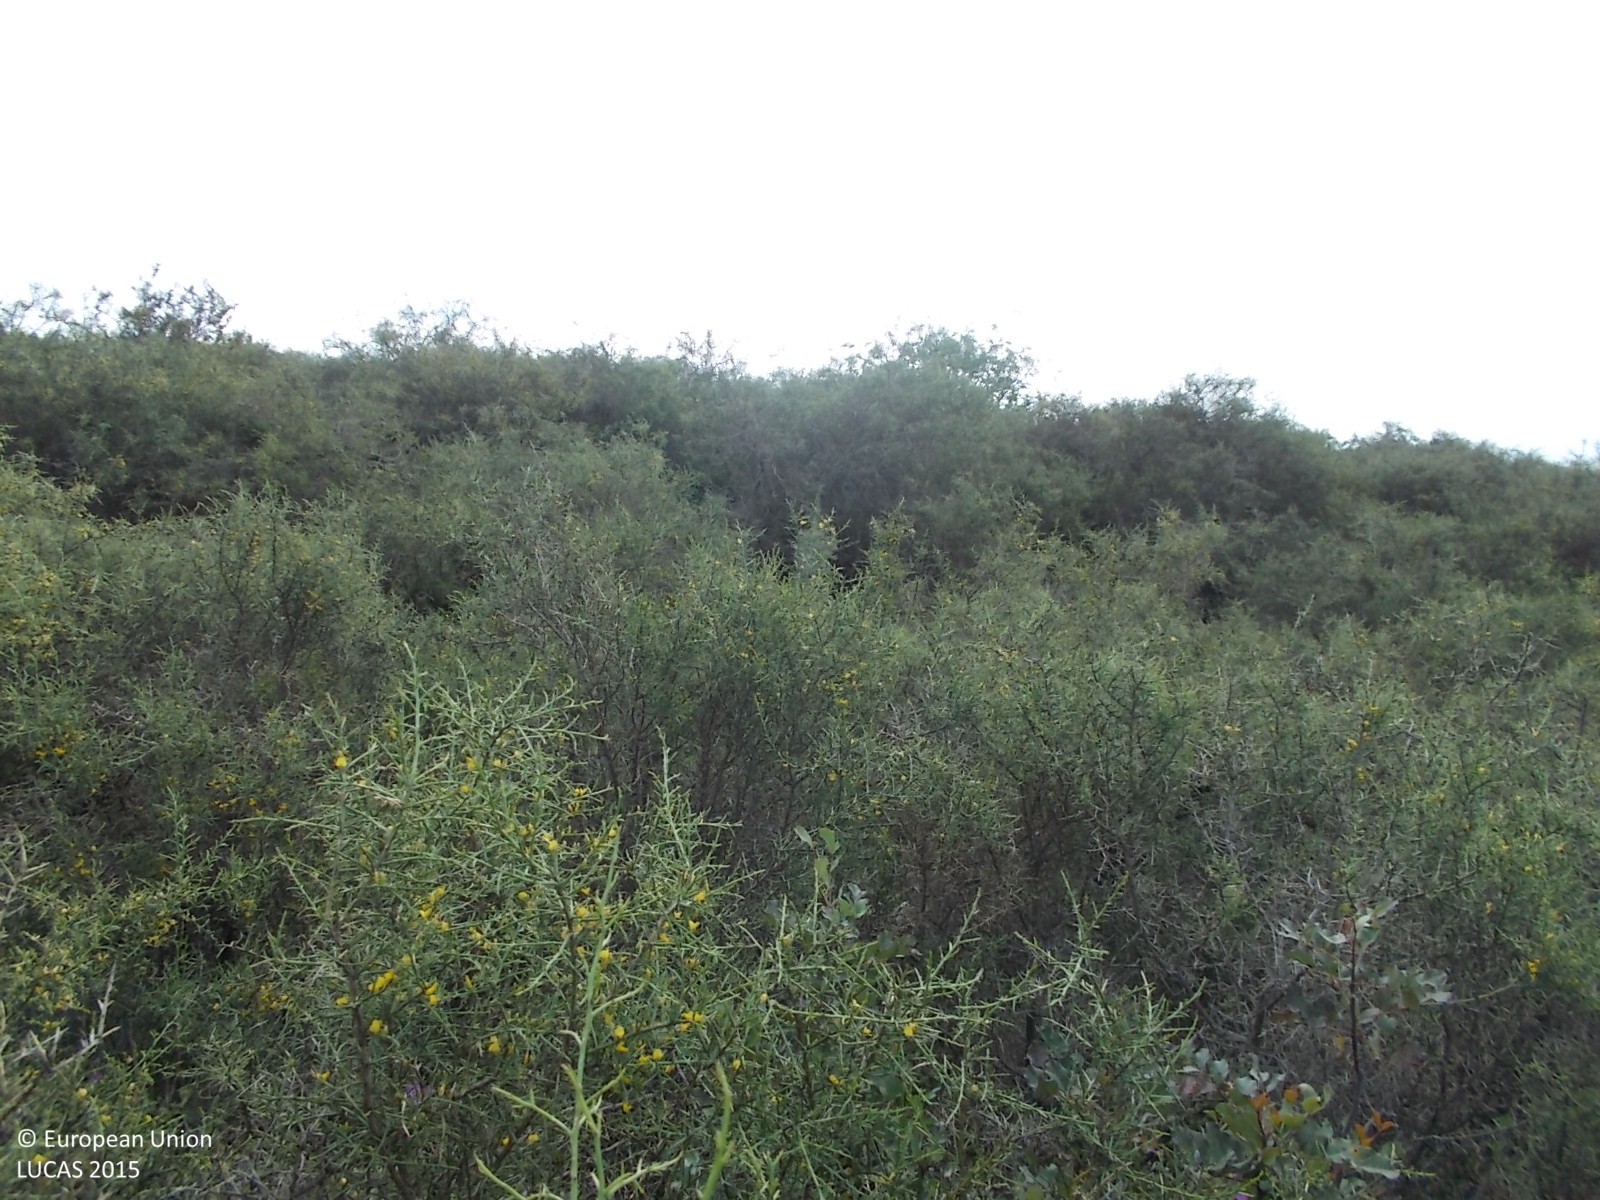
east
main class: Shrubland
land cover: Shrubland with sparse tree cover
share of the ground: > 75 %
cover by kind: shrubs 90 %, broadleaved forest trees 5 %, unconsolidated bare surface 5 %
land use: Semi-natural and natural areas not in use
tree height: < 5 m
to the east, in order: Shrubland with sparse tree cover; Shrubland without tree cover; Rock outcrops; Shrubland with sparse tree cover; Shrubland without tree cover; Shrubland with sparse tree cover
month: May
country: CY
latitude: 34.8803
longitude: 32.4351
